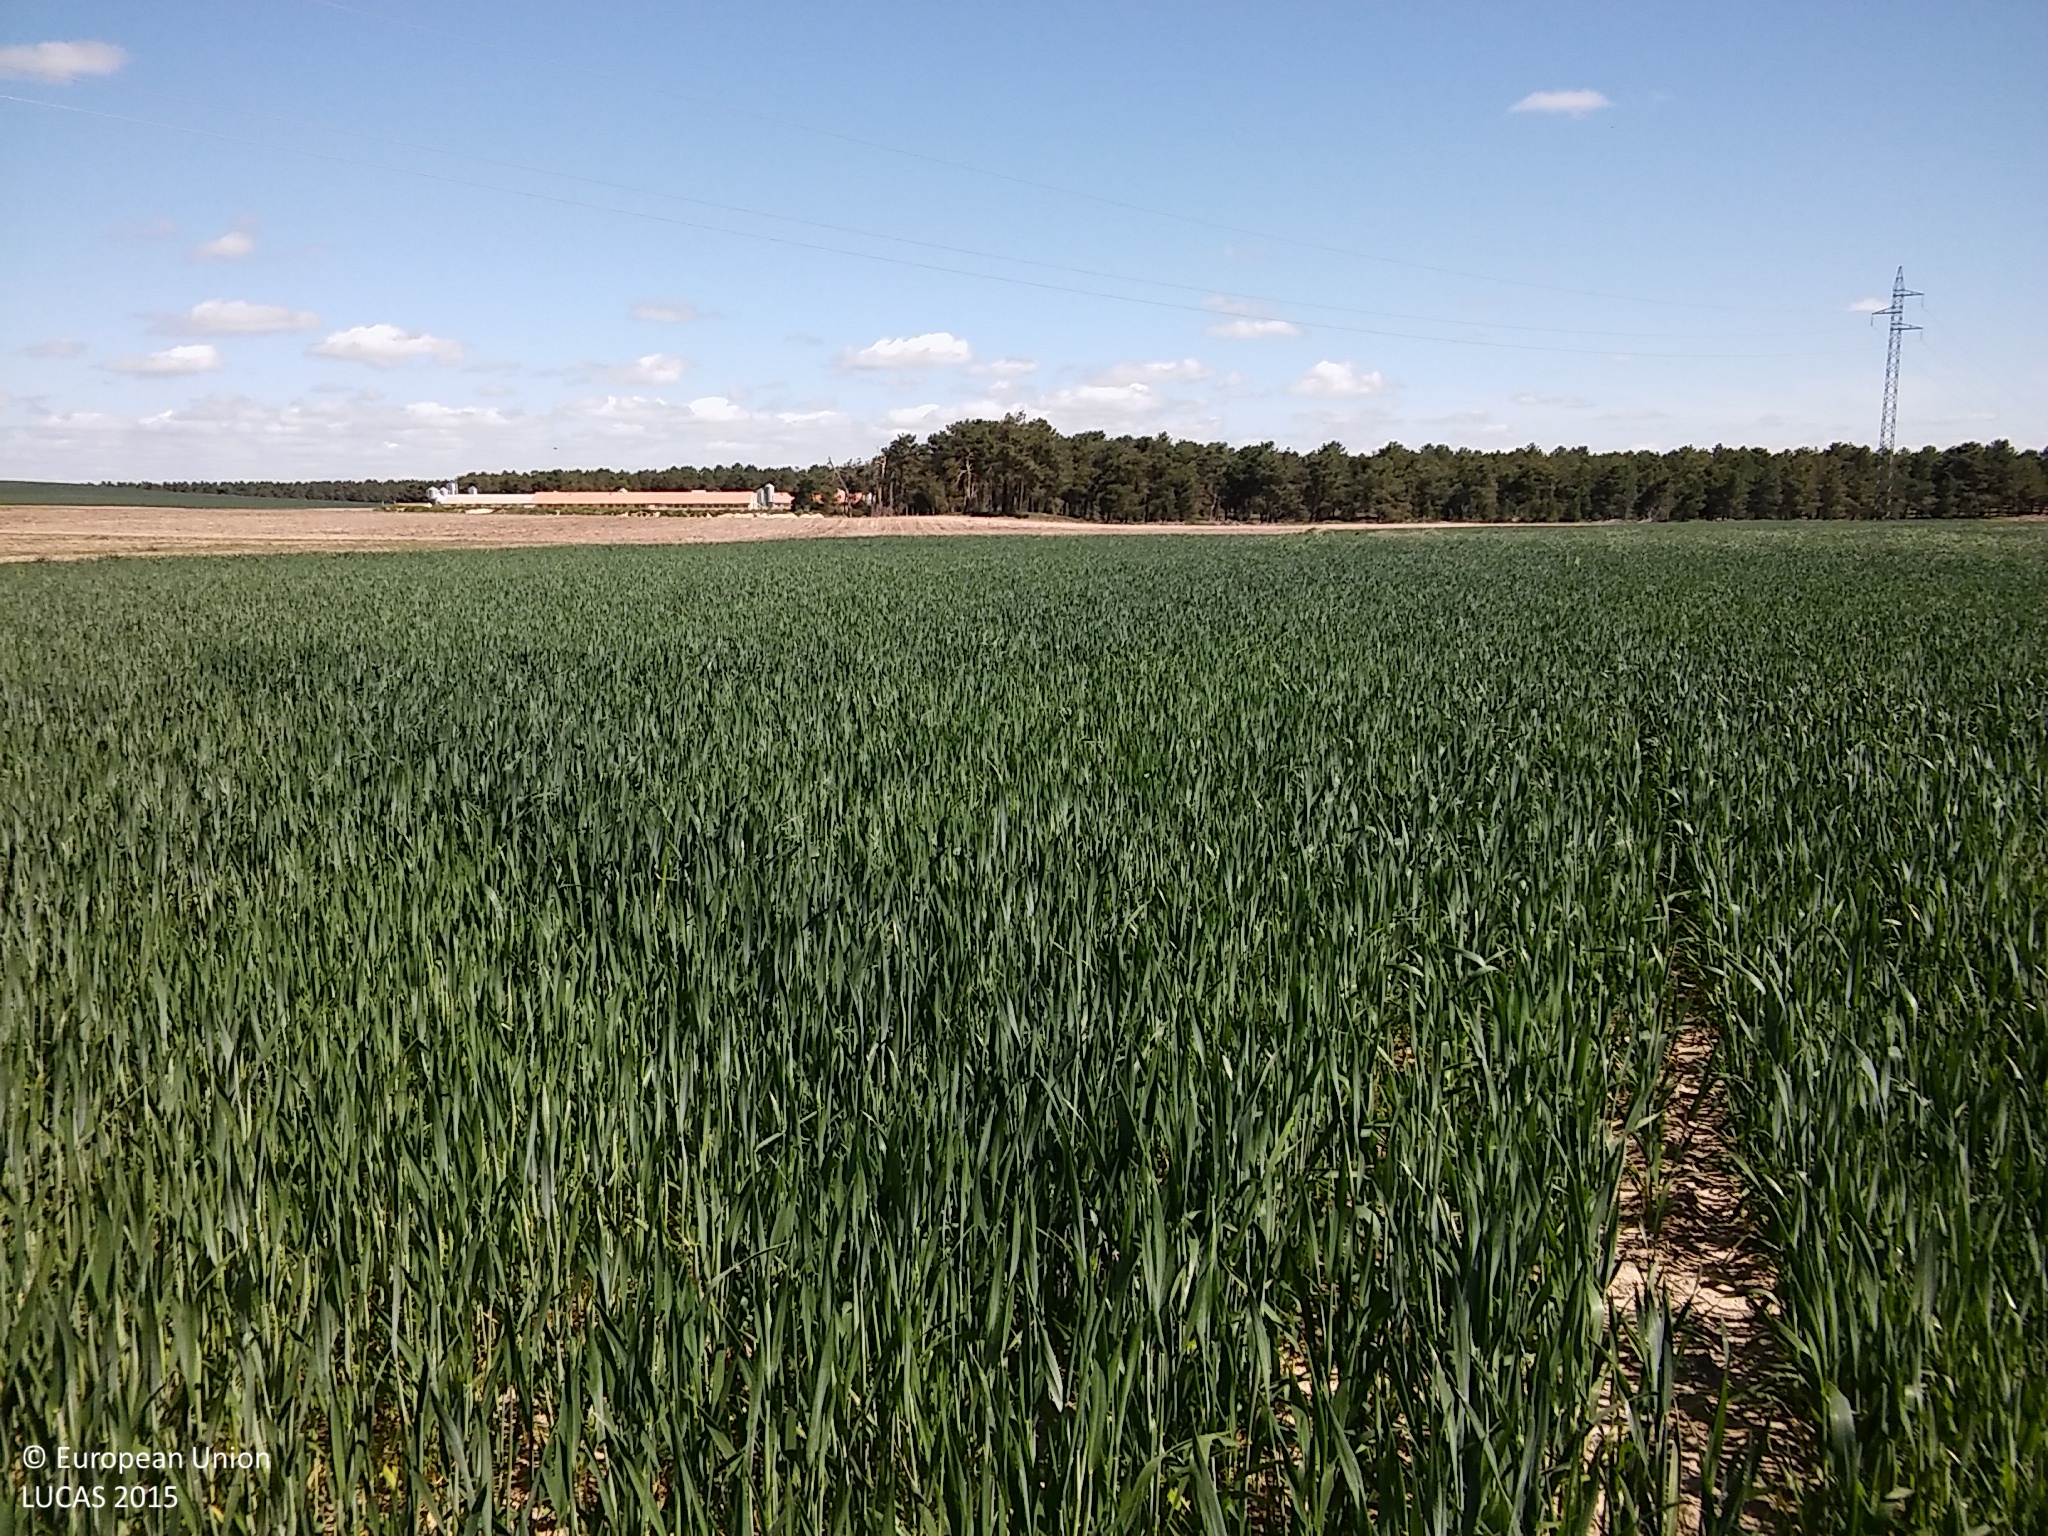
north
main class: Cropland
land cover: Common wheat
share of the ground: > 75 %
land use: Agriculture (excluding fallow land and kitchen gardens)
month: May
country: ES
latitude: 41.2014
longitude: -3.9918
